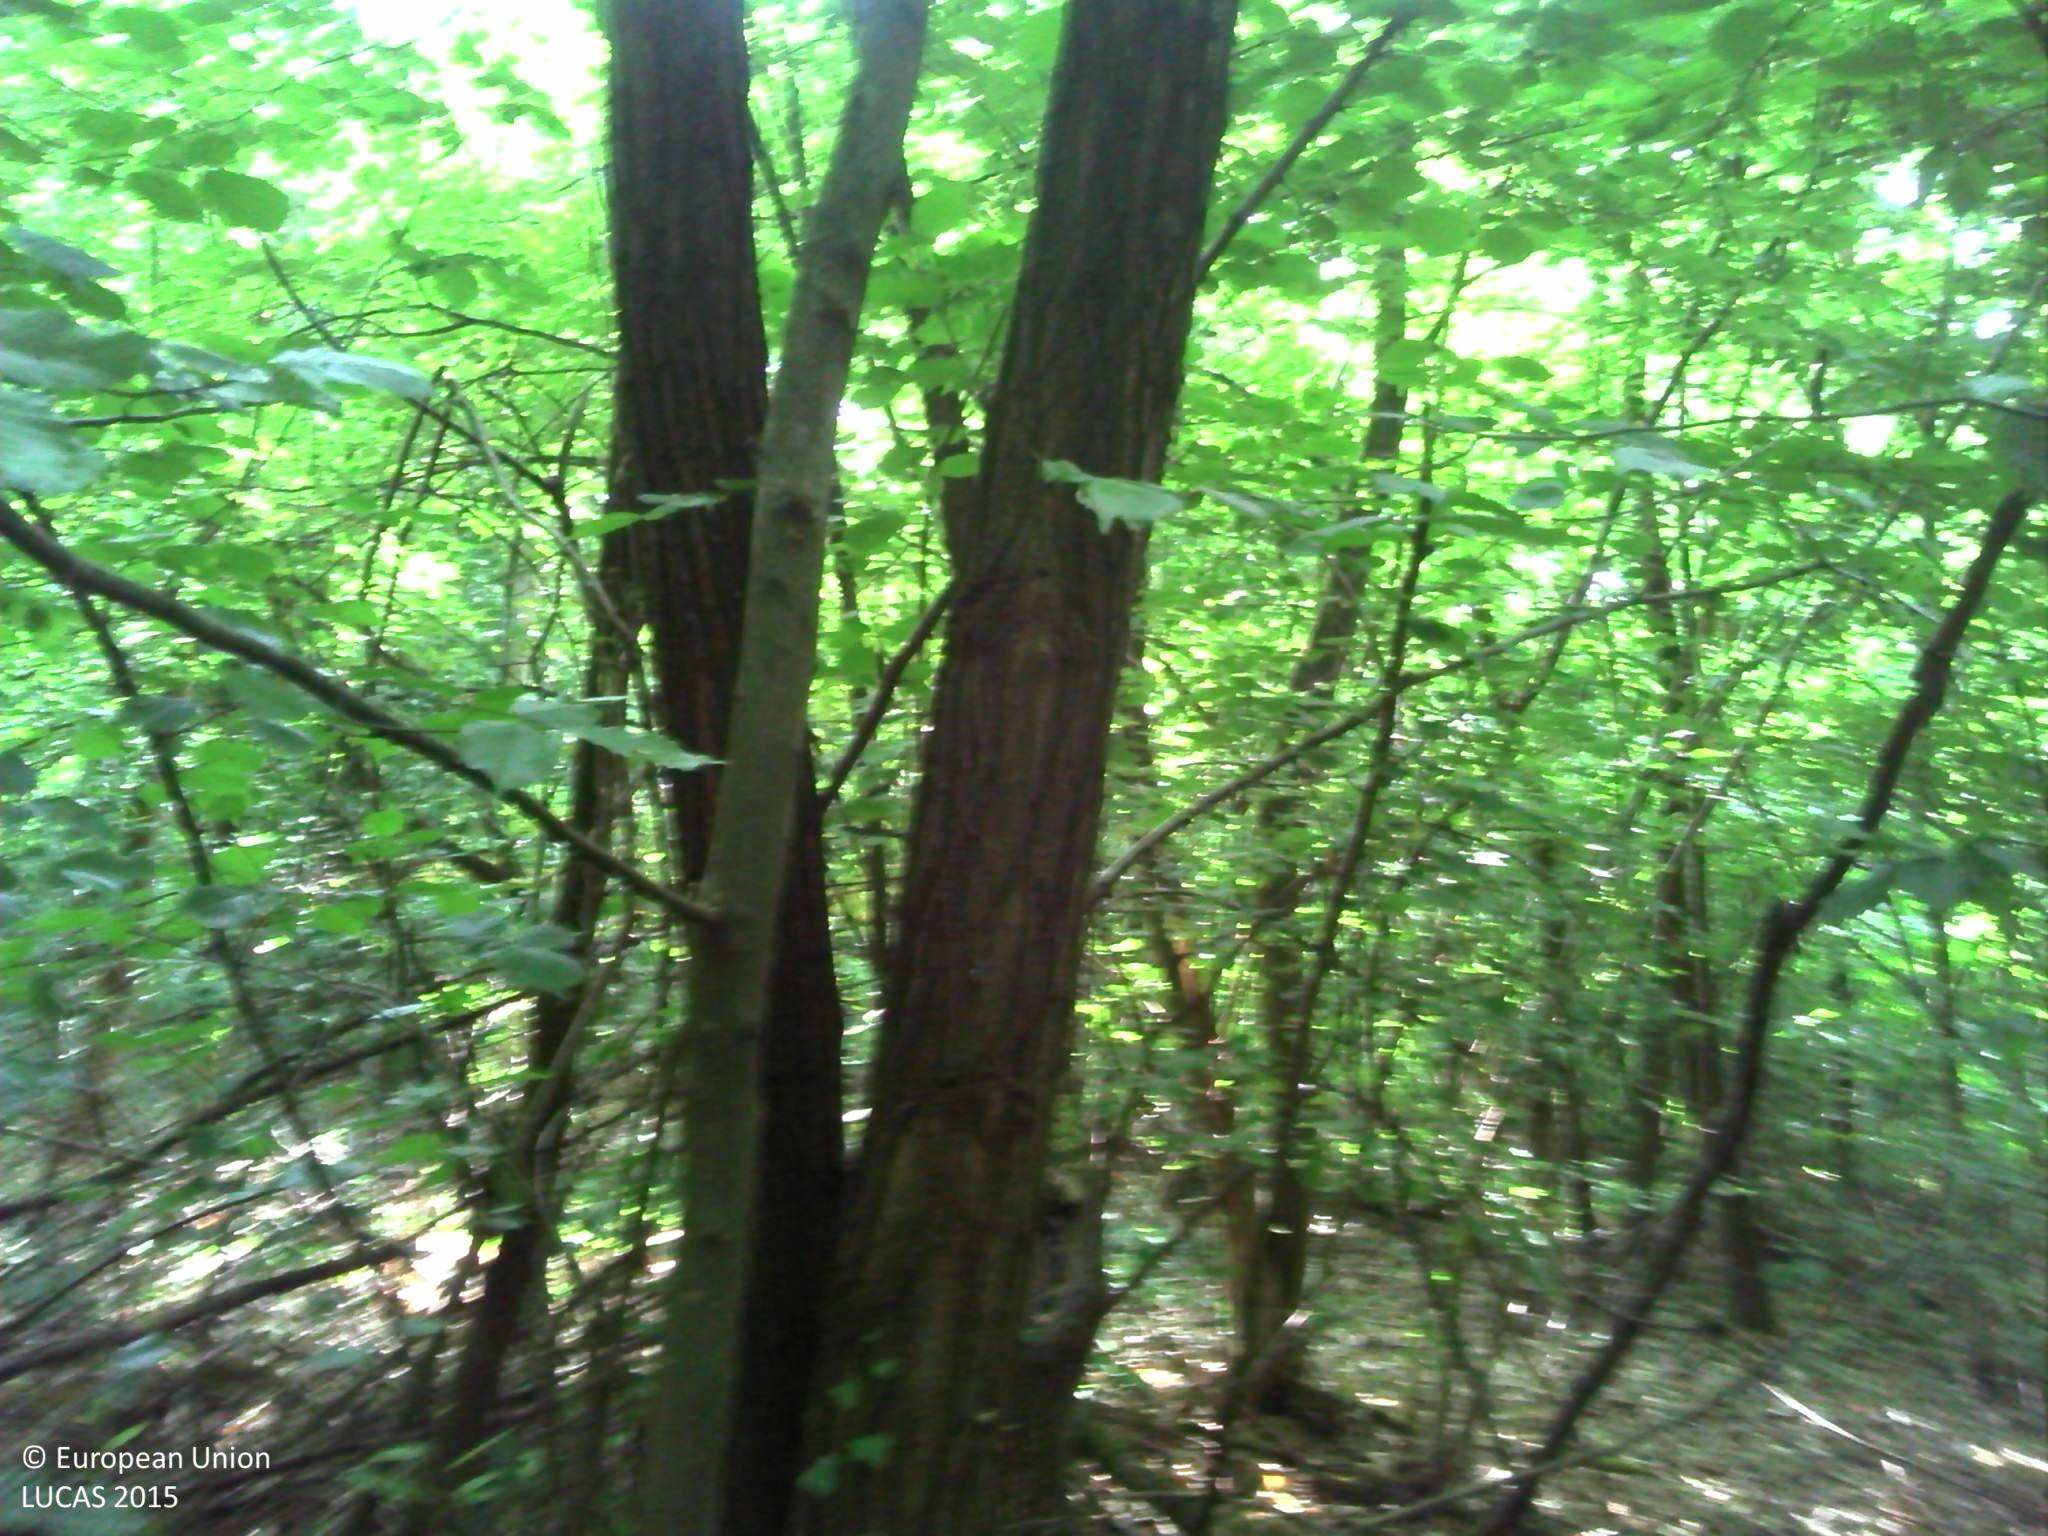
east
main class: Woodland
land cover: Broadleaved woodland
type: acidophilous oak and oak-birch forest
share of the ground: > 75 %
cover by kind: broadleaved forest trees 85 %, herbaceous plants 15 %
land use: Forestry
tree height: > 5 m
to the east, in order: Broadleaved woodland; Rivers and streams; Fences; Spontaneously vegetated surfaces; Maize; Fences; Shrubland with sparse tree cover; Grassland without tree/shrub cover
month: June
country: FR
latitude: 46.1004
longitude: 4.8414
